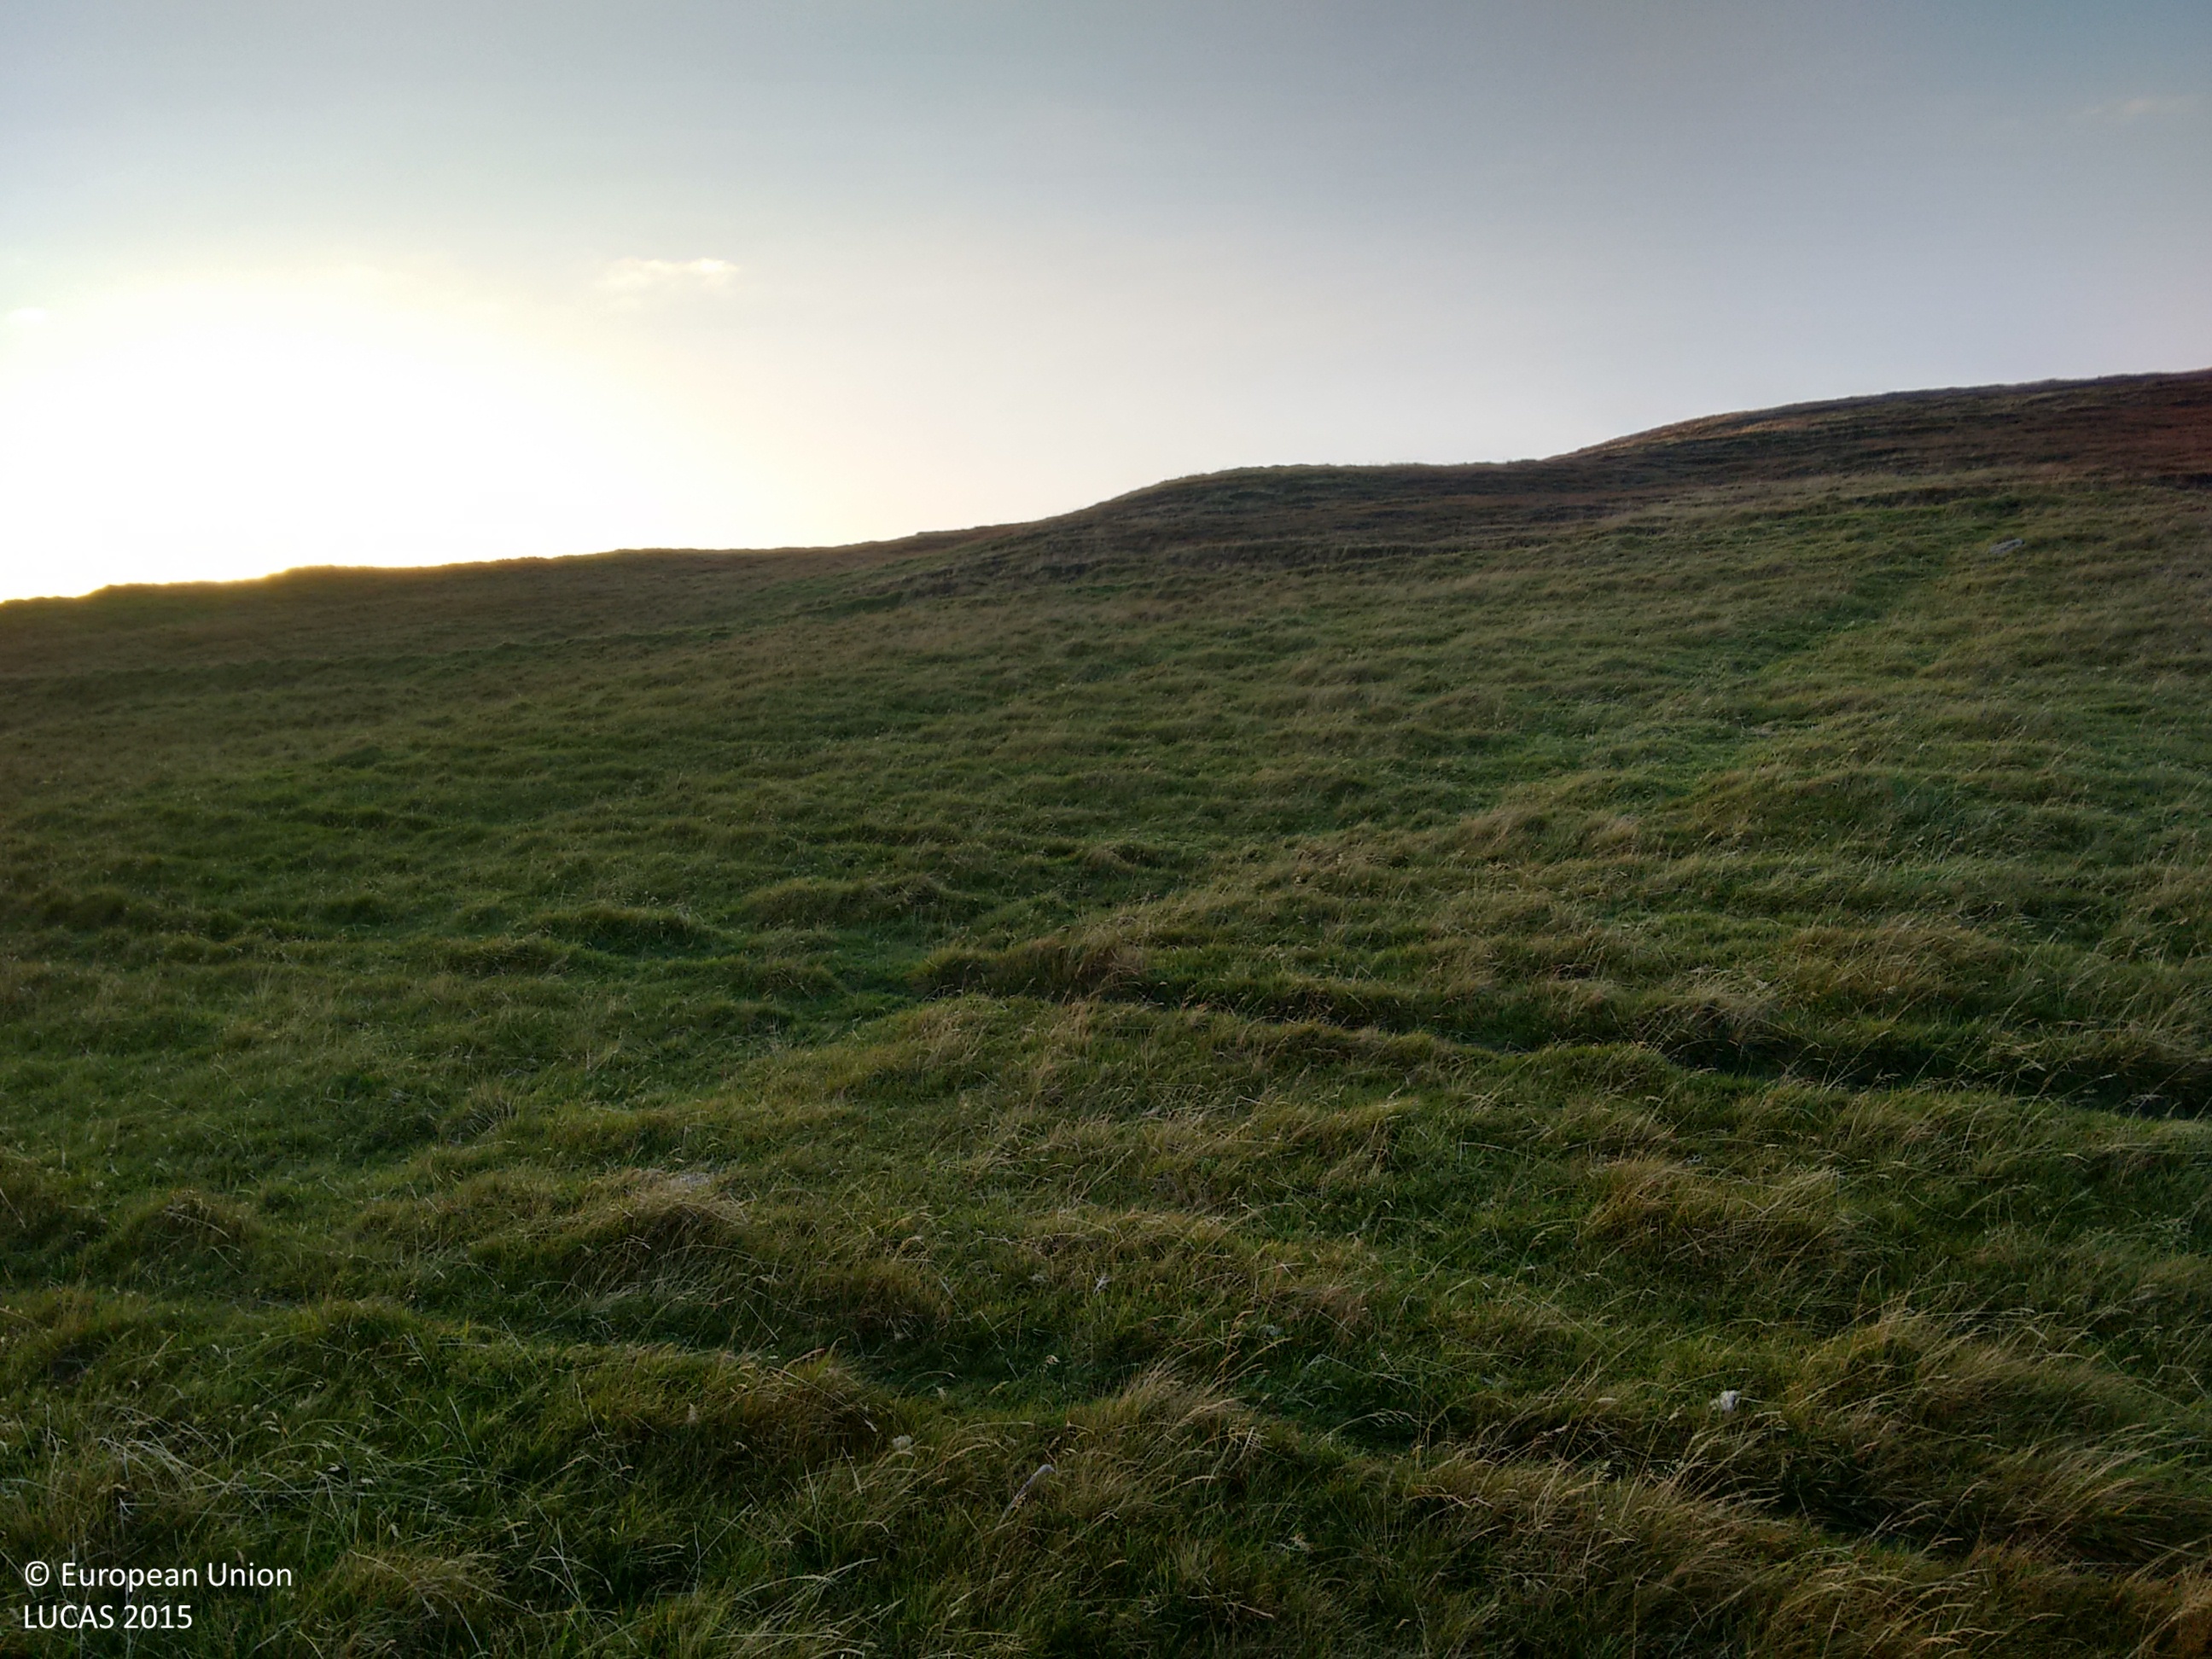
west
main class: Grassland
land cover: Grassland without tree/shrub cover
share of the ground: > 75 %
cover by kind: herbaceous plants 100 %
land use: Agriculture (excluding fallow land and kitchen gardens)
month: November
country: GB
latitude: 60.2047
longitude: -1.2230
